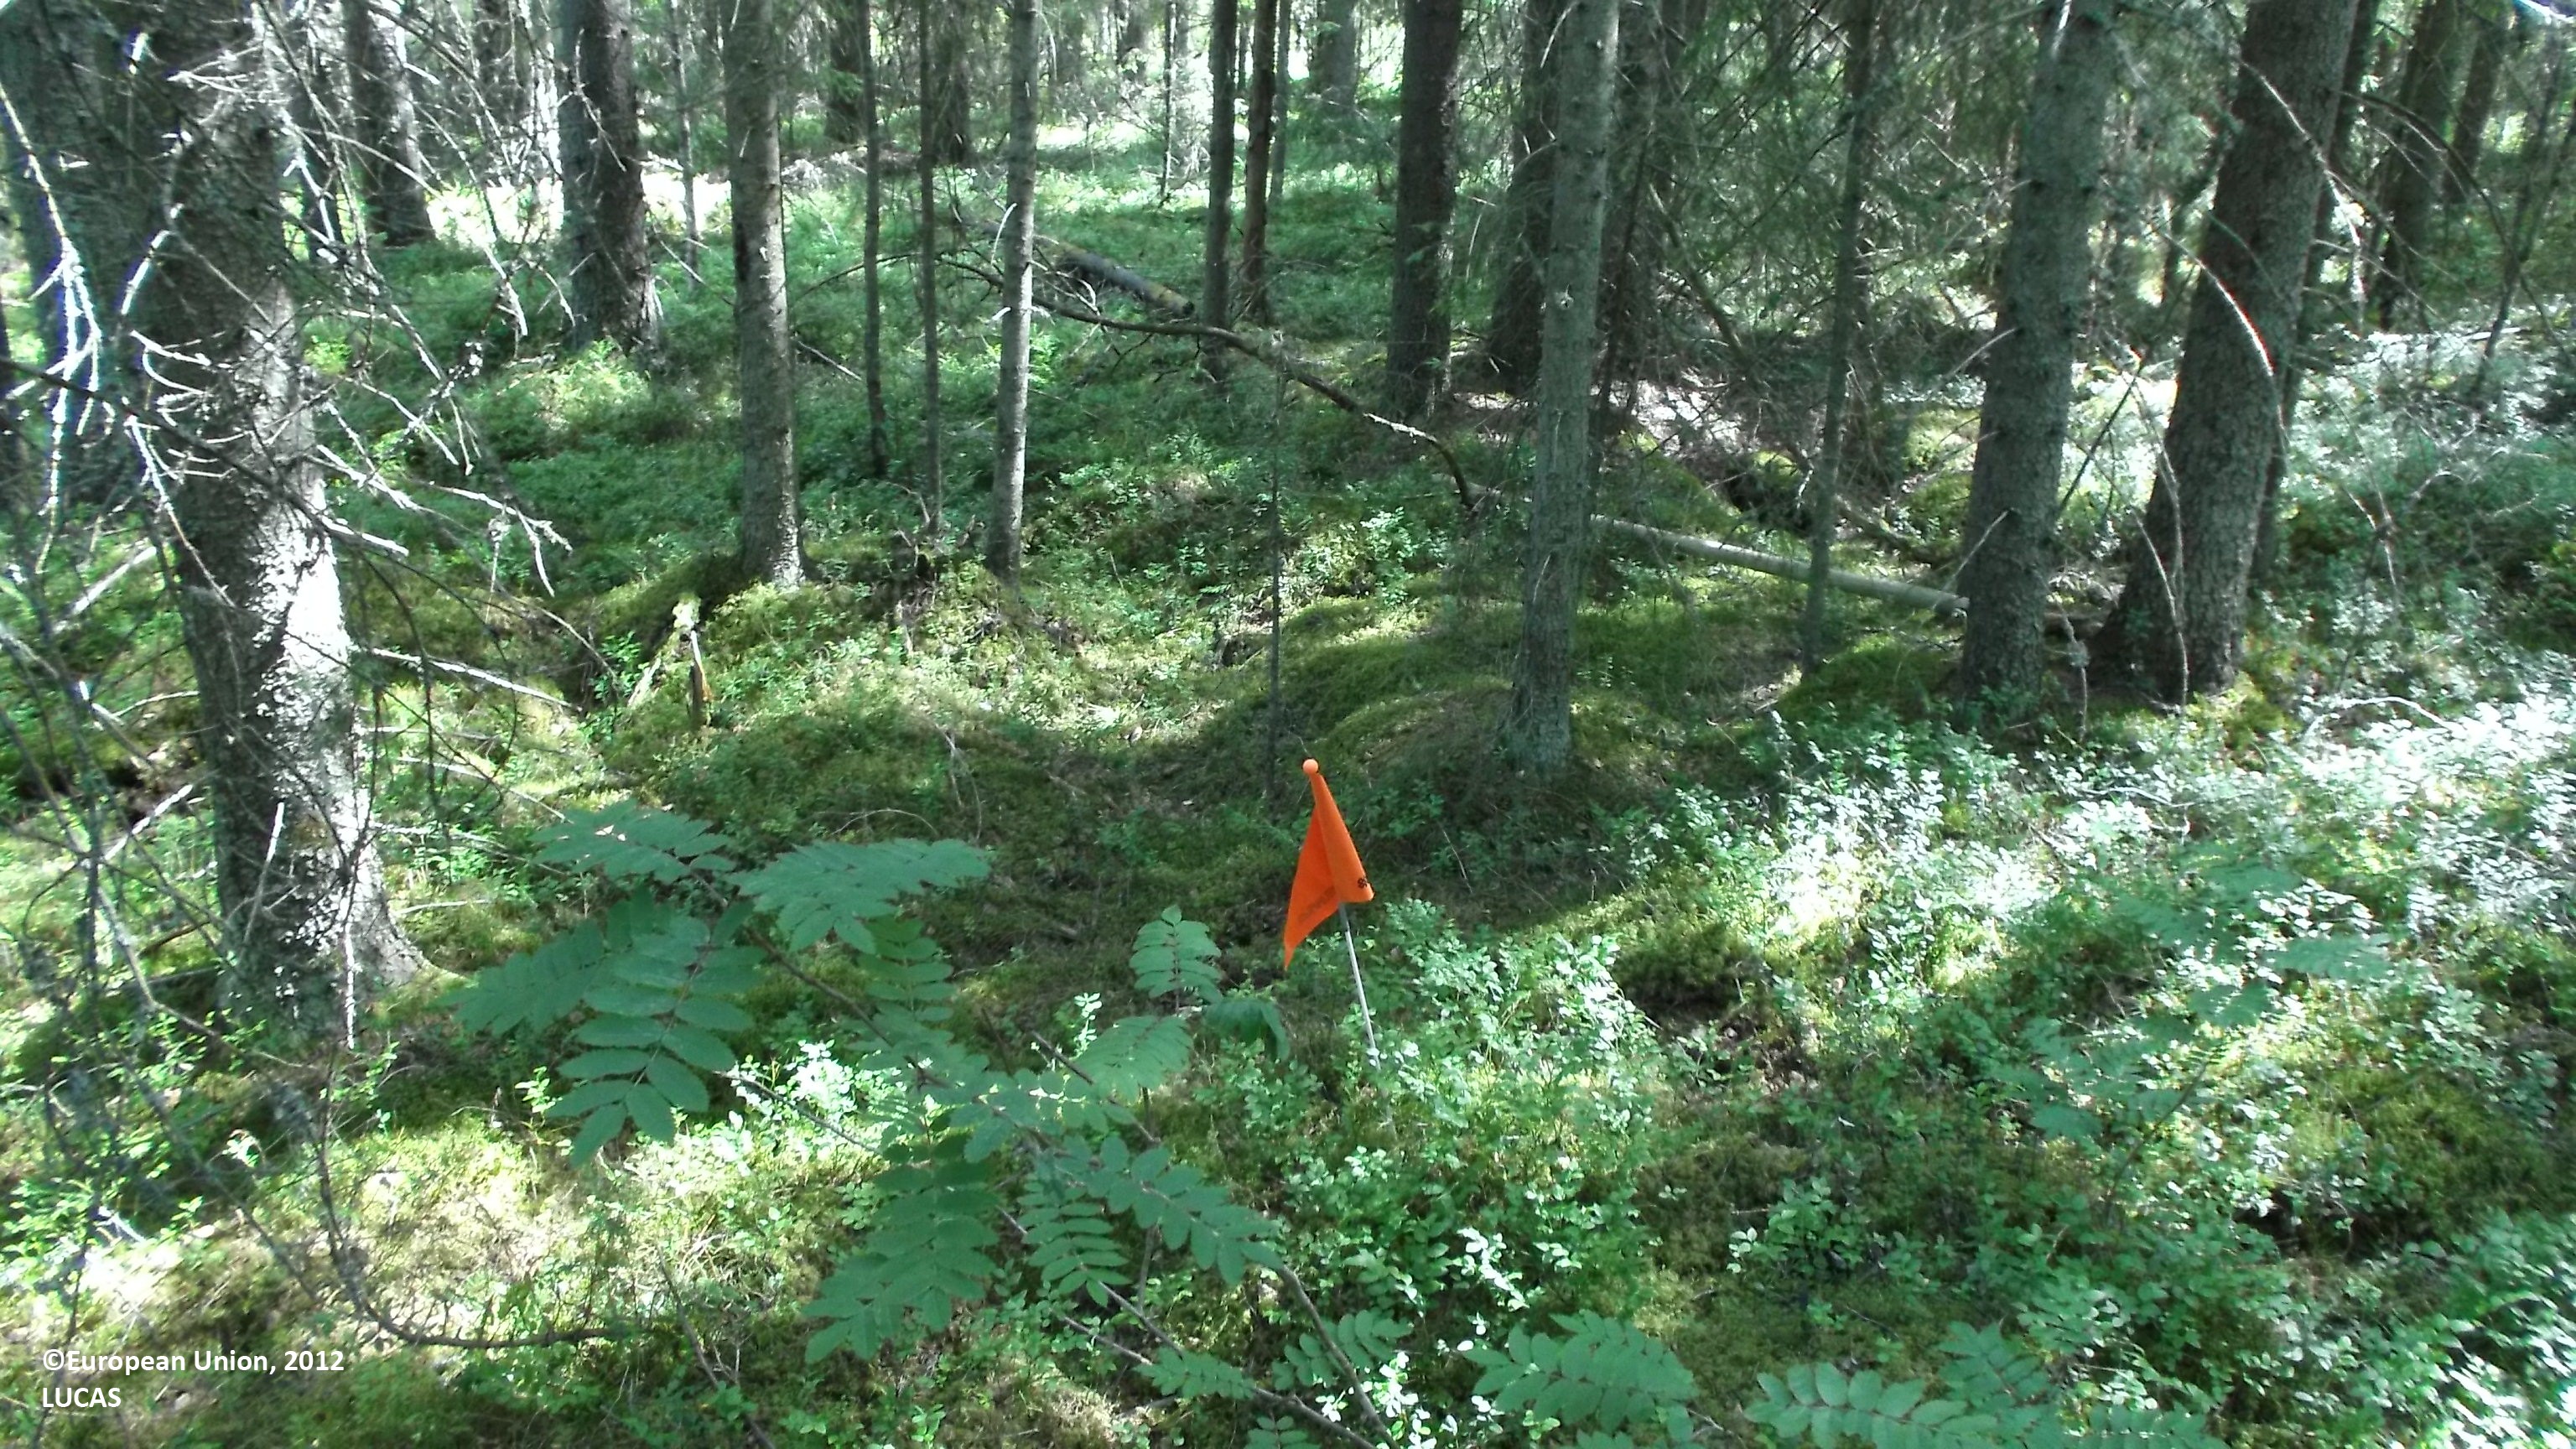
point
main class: Woodland
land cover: Spruce dominated coniferous woodland
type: boreal forest
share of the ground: > 75 %
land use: Forestry
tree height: > 5 m
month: July
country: FI
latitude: 63.6642
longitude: 23.9891
